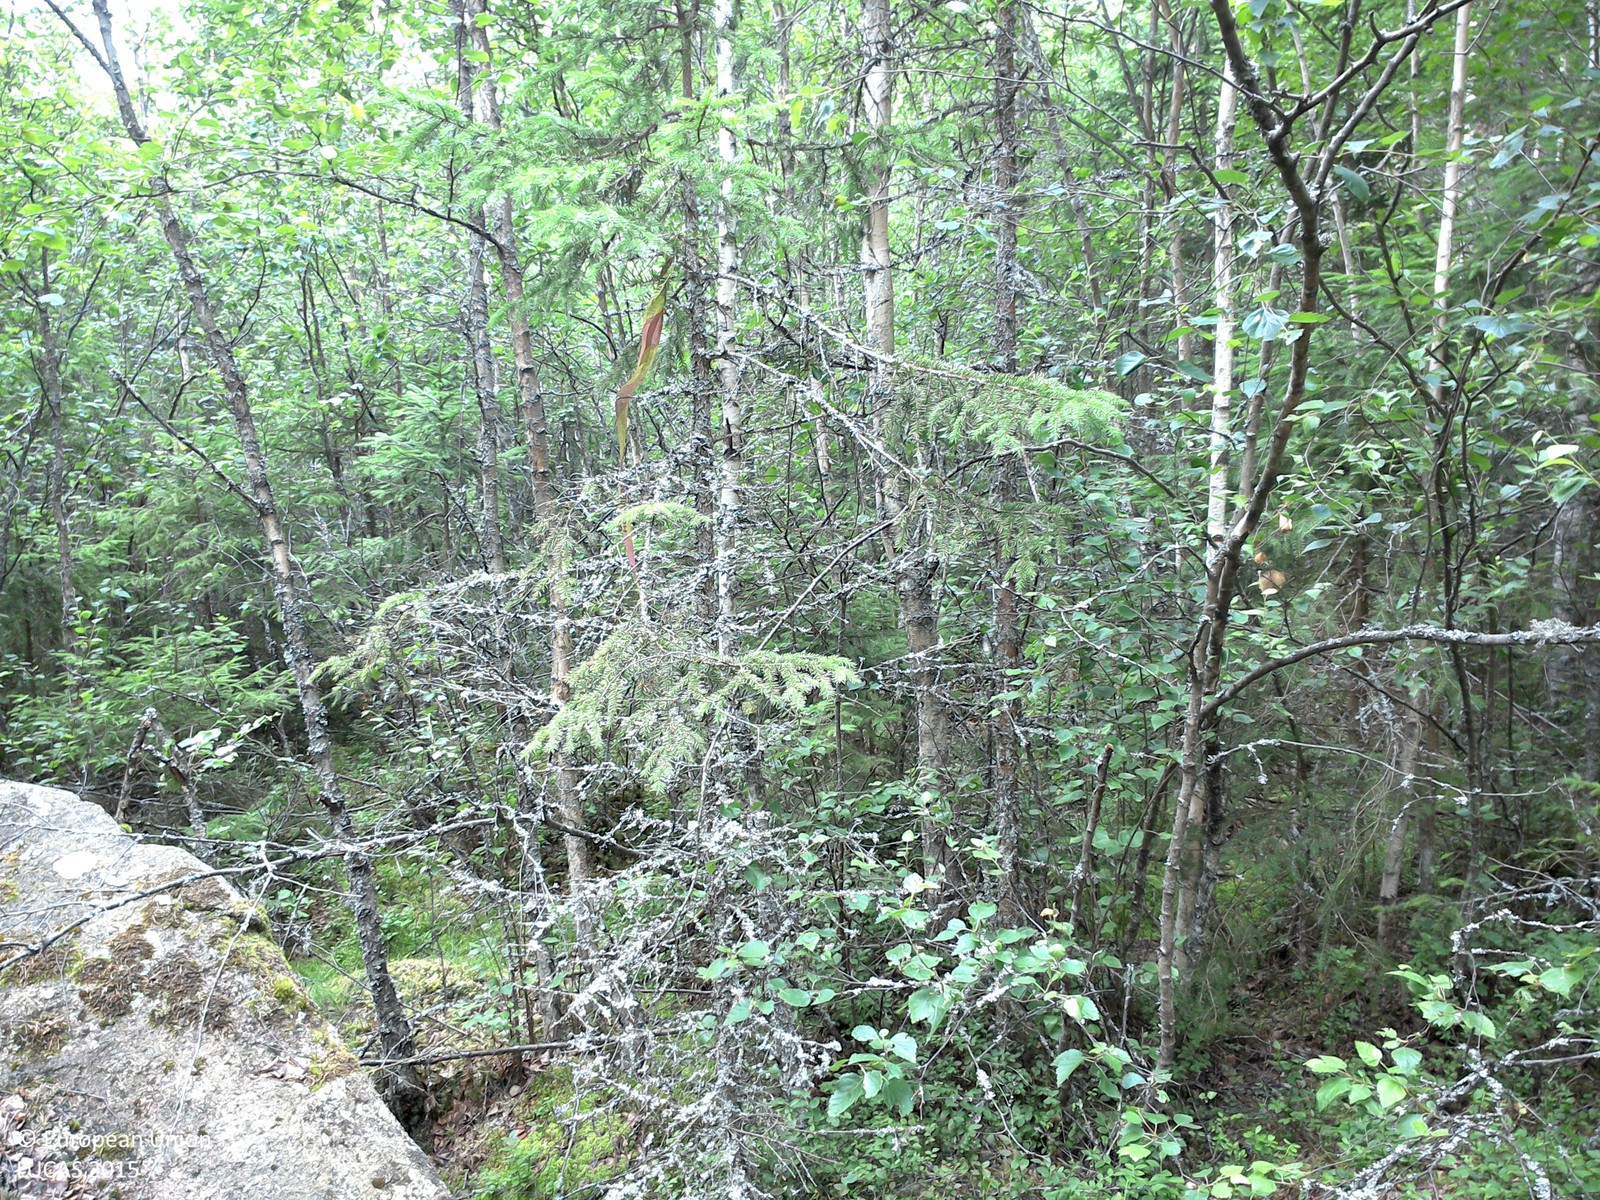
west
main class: Woodland
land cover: Spruce dominated mixed woodland
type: boreal forest
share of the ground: > 75 %
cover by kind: coniferous forest trees 55 %, broadleaved forest trees 20 %, lichens and mosses 20 %, herbaceous plants 5 %
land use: Forestry
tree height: > 5 m
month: July
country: SE
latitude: 58.2259
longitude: 14.7447
